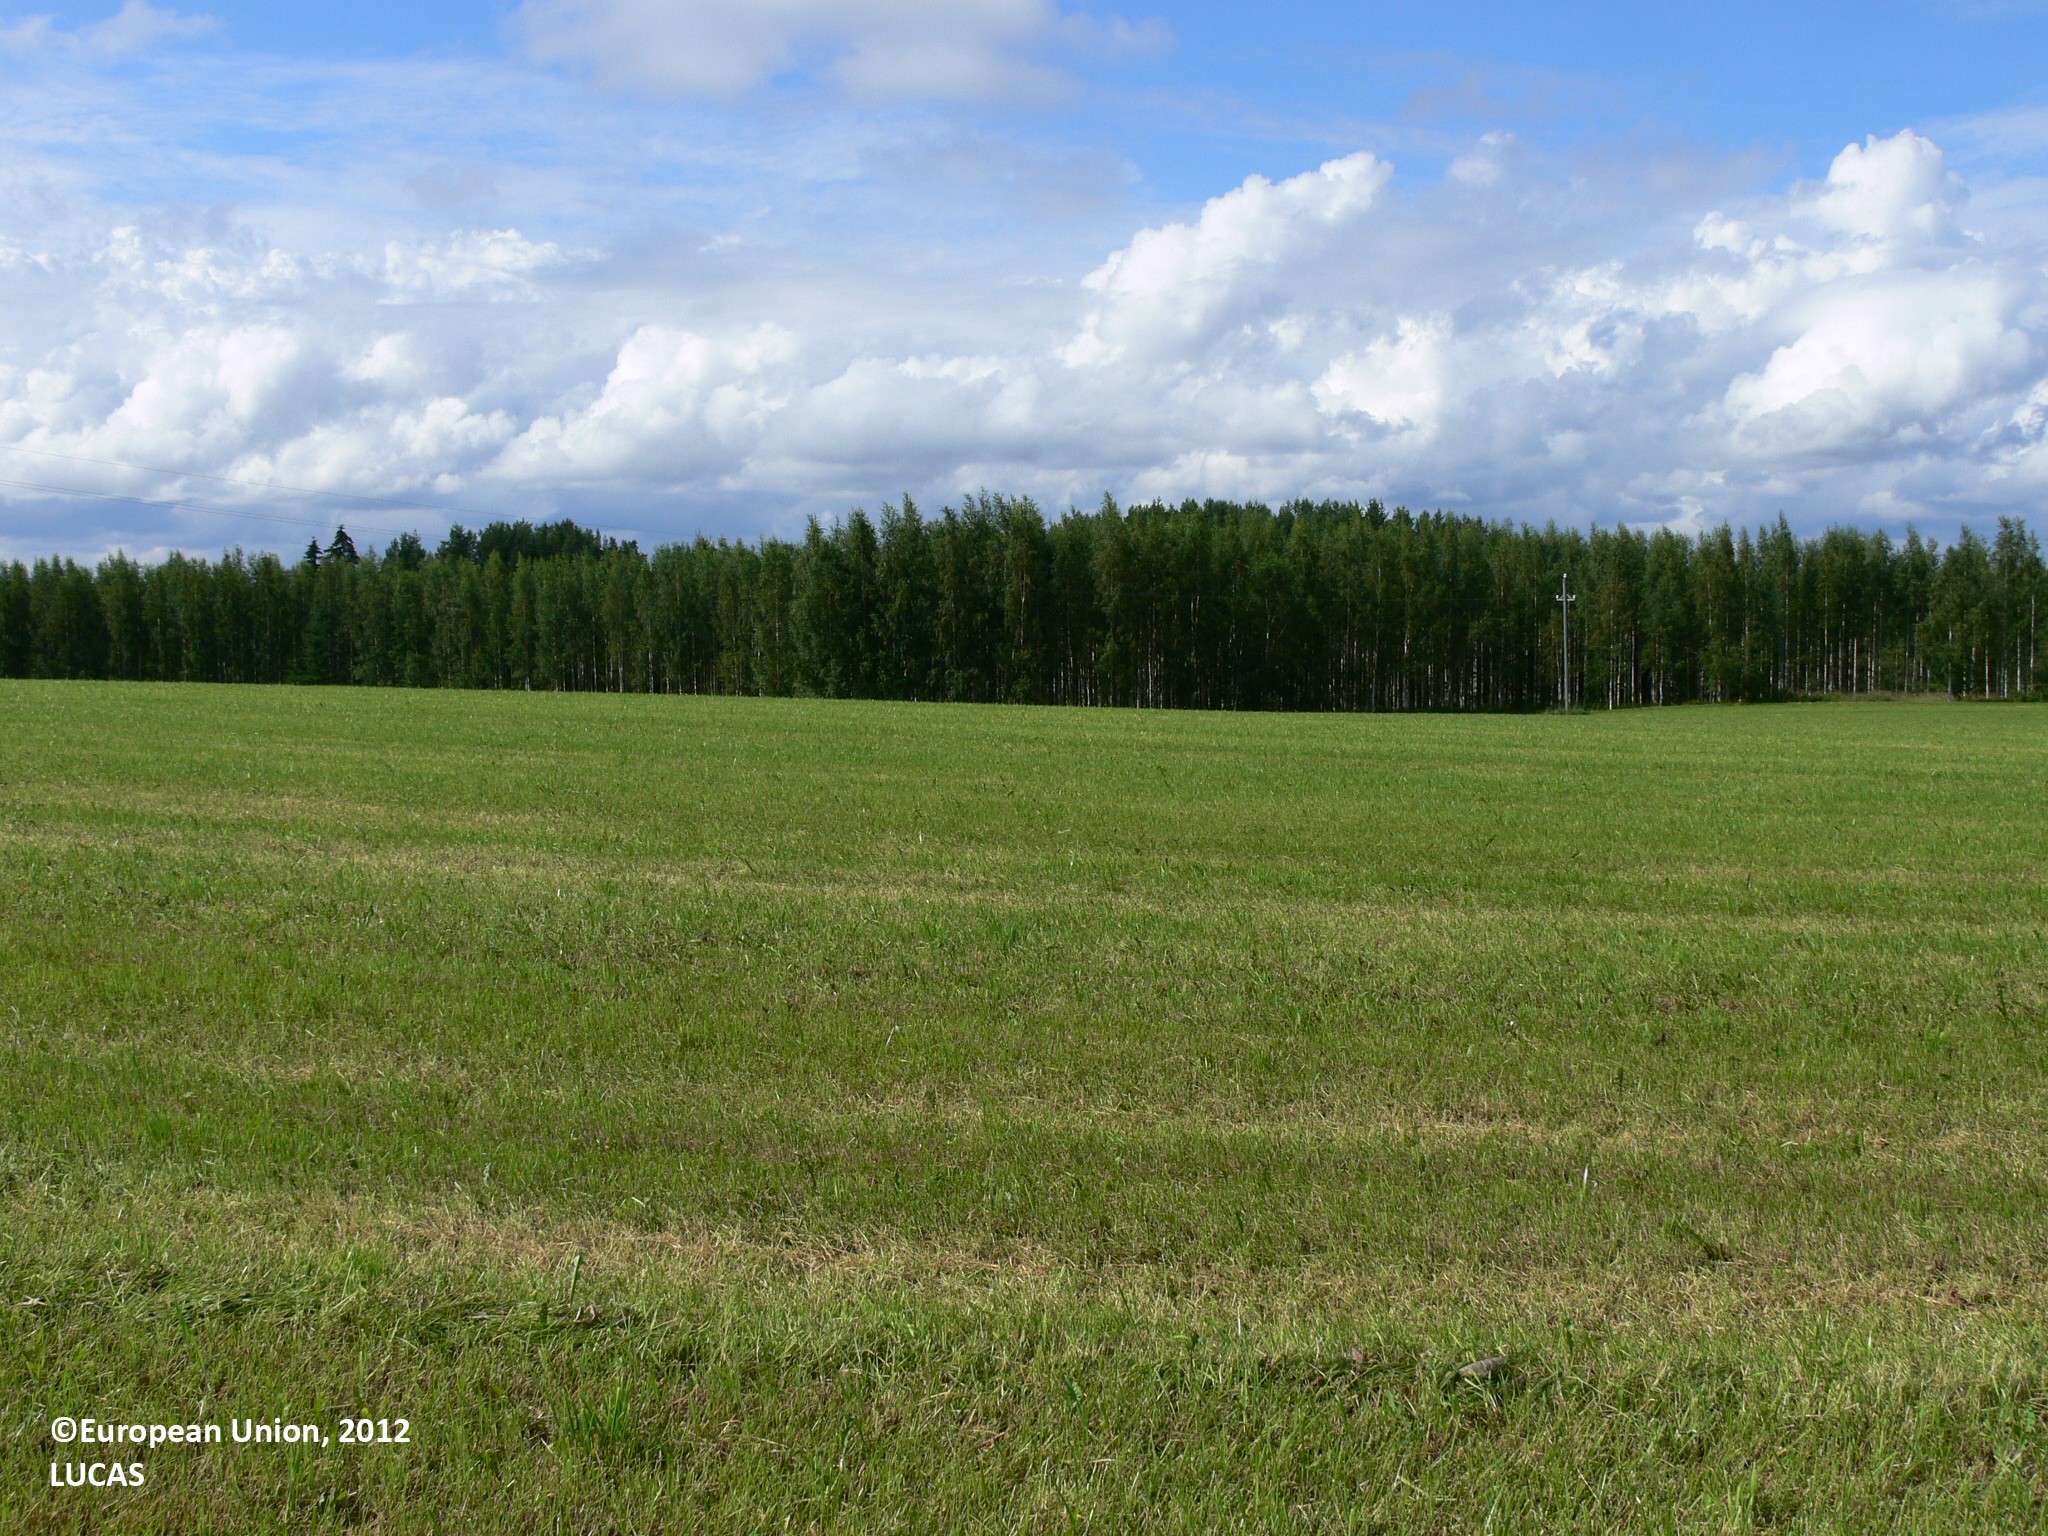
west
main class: Cropland
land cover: Temporary grasslands
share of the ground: 25 - 50 %
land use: Agriculture (excluding fallow land and kitchen gardens)
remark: Harvested field
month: August
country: FI
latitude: 61.6655
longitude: 29.8099
